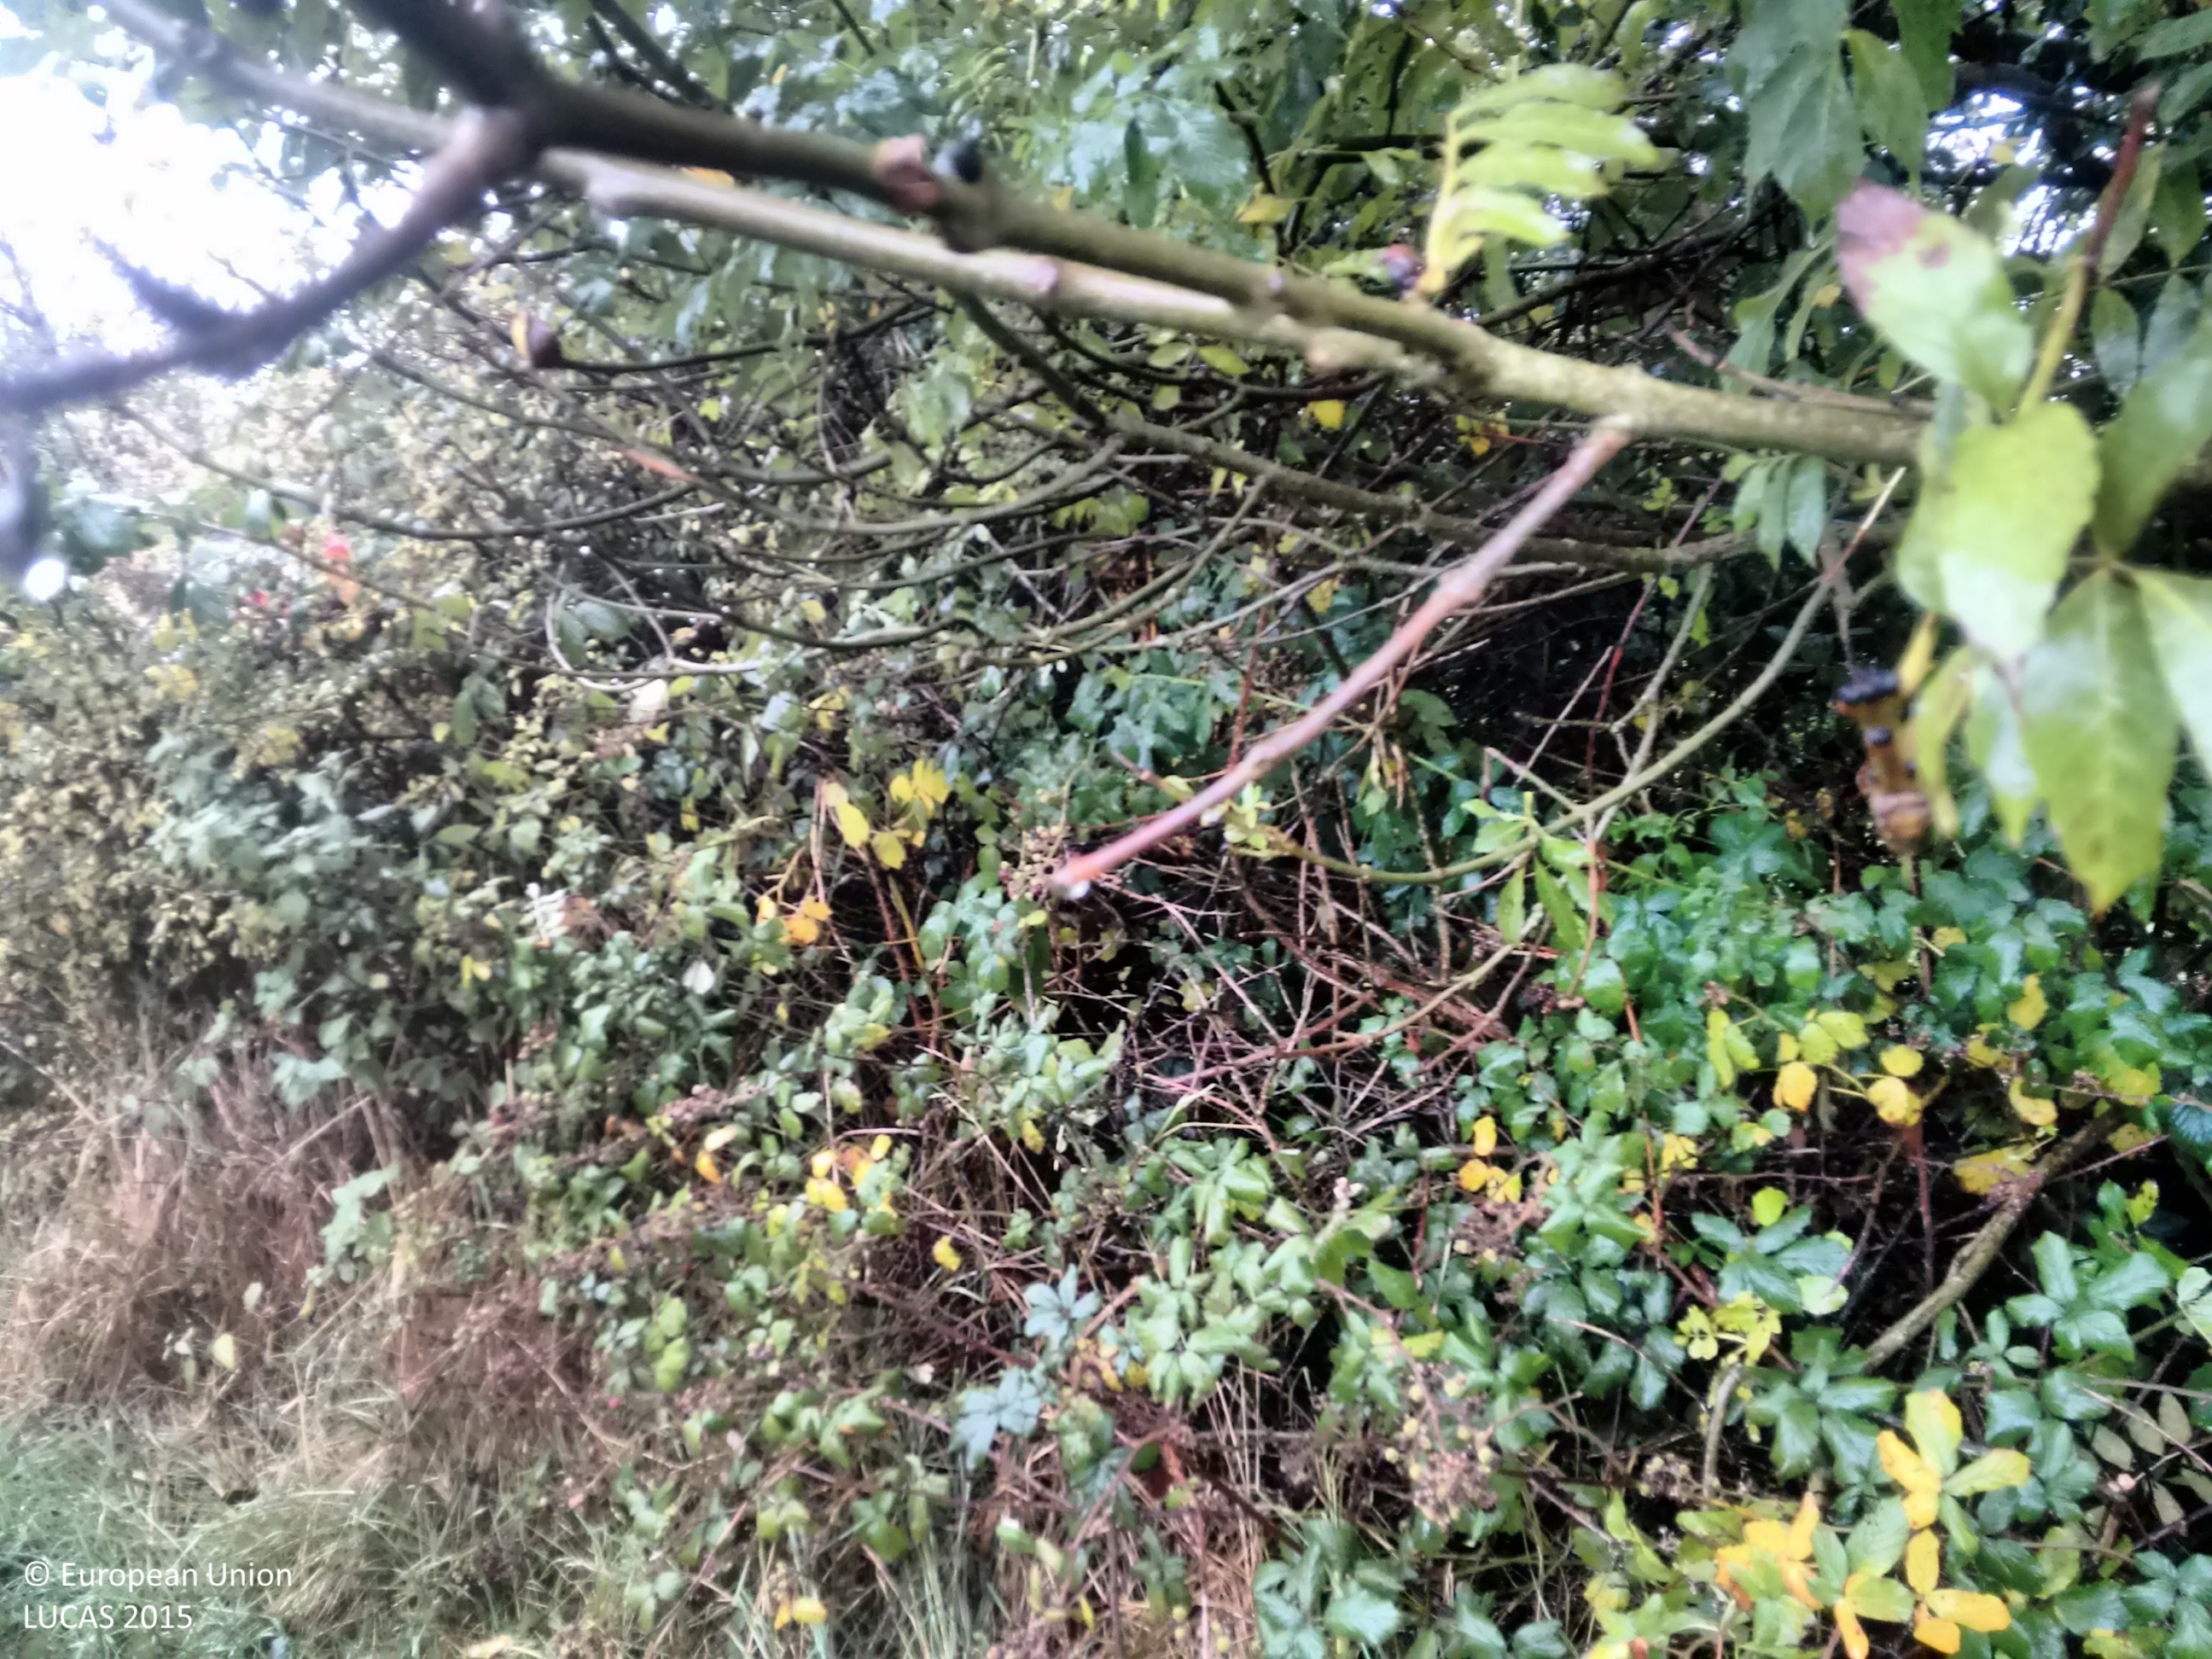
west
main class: Grassland
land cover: Grassland without tree/shrub cover
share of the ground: > 75 %
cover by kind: herbaceous plants 100 %
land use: Agriculture (excluding fallow land and kitchen gardens)
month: October
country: IE
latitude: 53.9654
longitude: -8.1828
